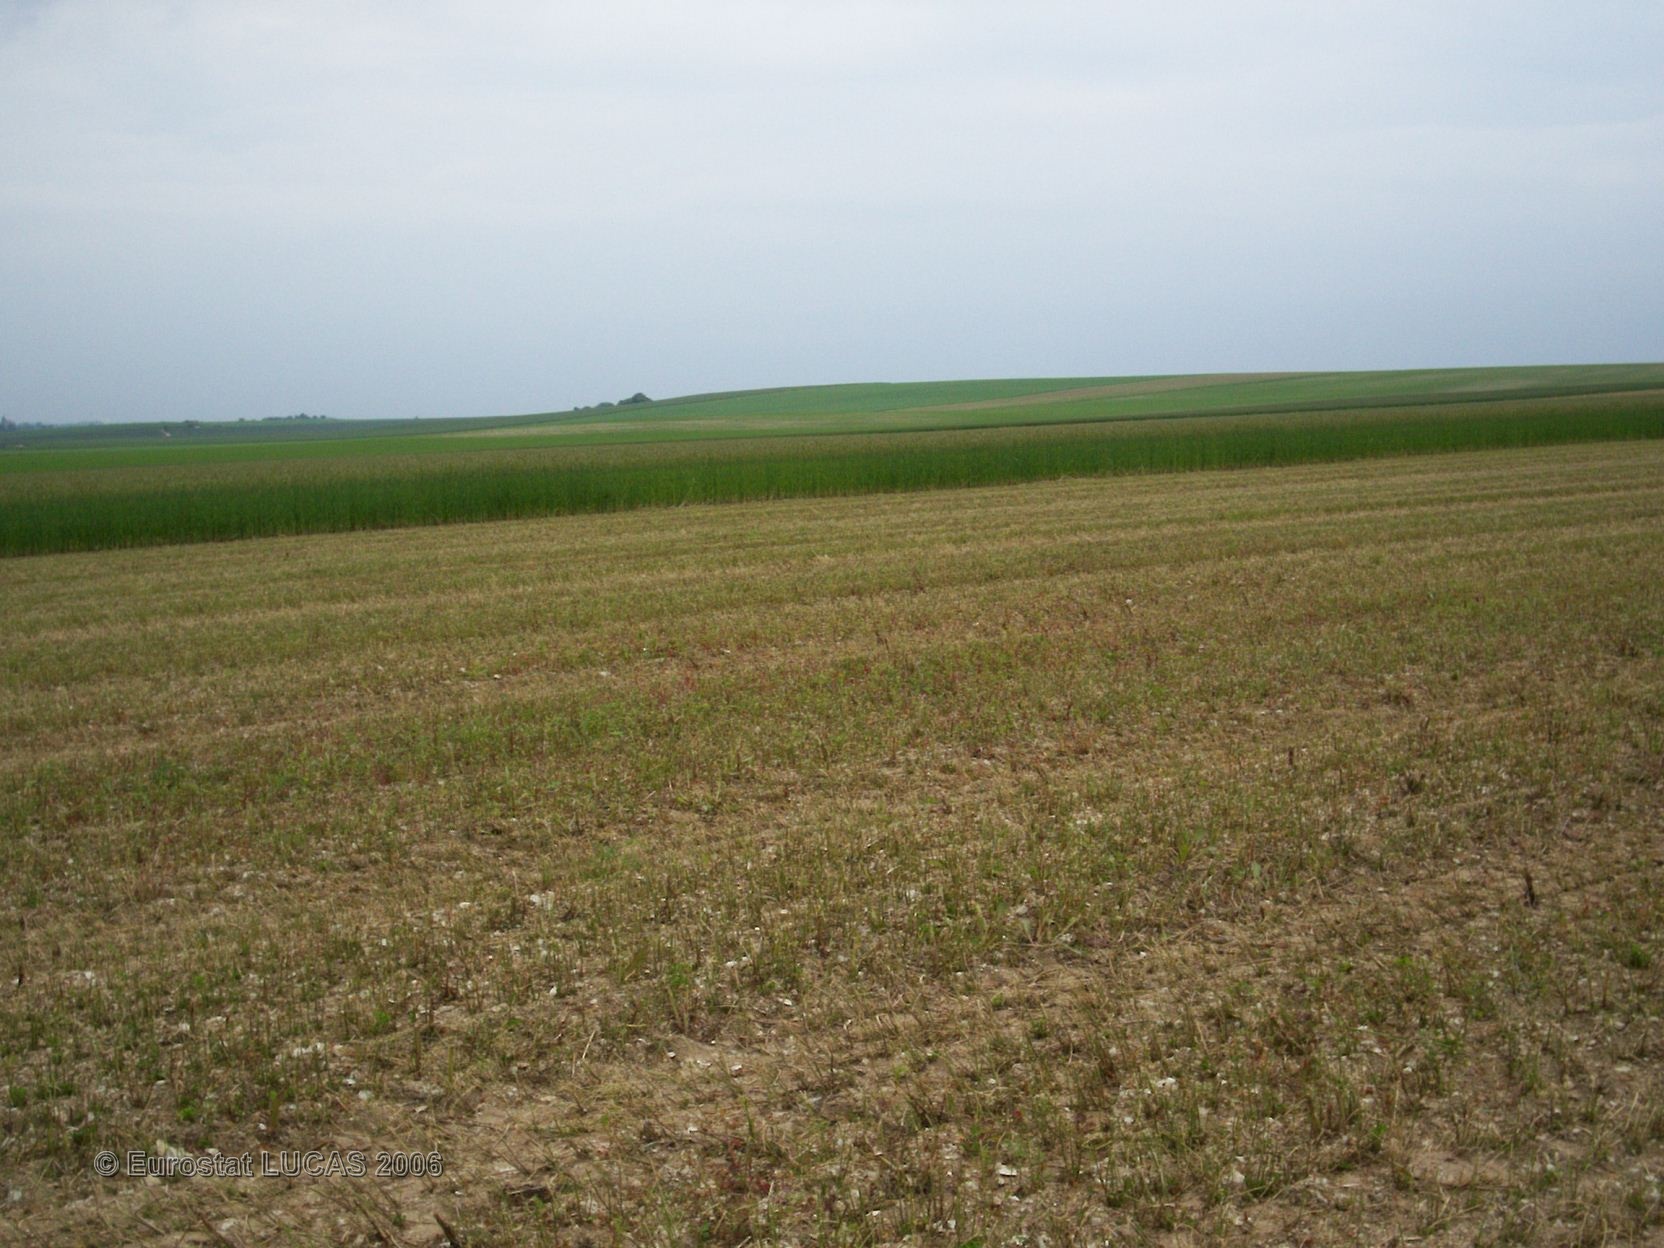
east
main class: Cropland
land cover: Lucerne
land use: Agriculture (excluding fallow land and kitchen gardens)
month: June
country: FR
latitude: 48.6812
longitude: 4.4962
